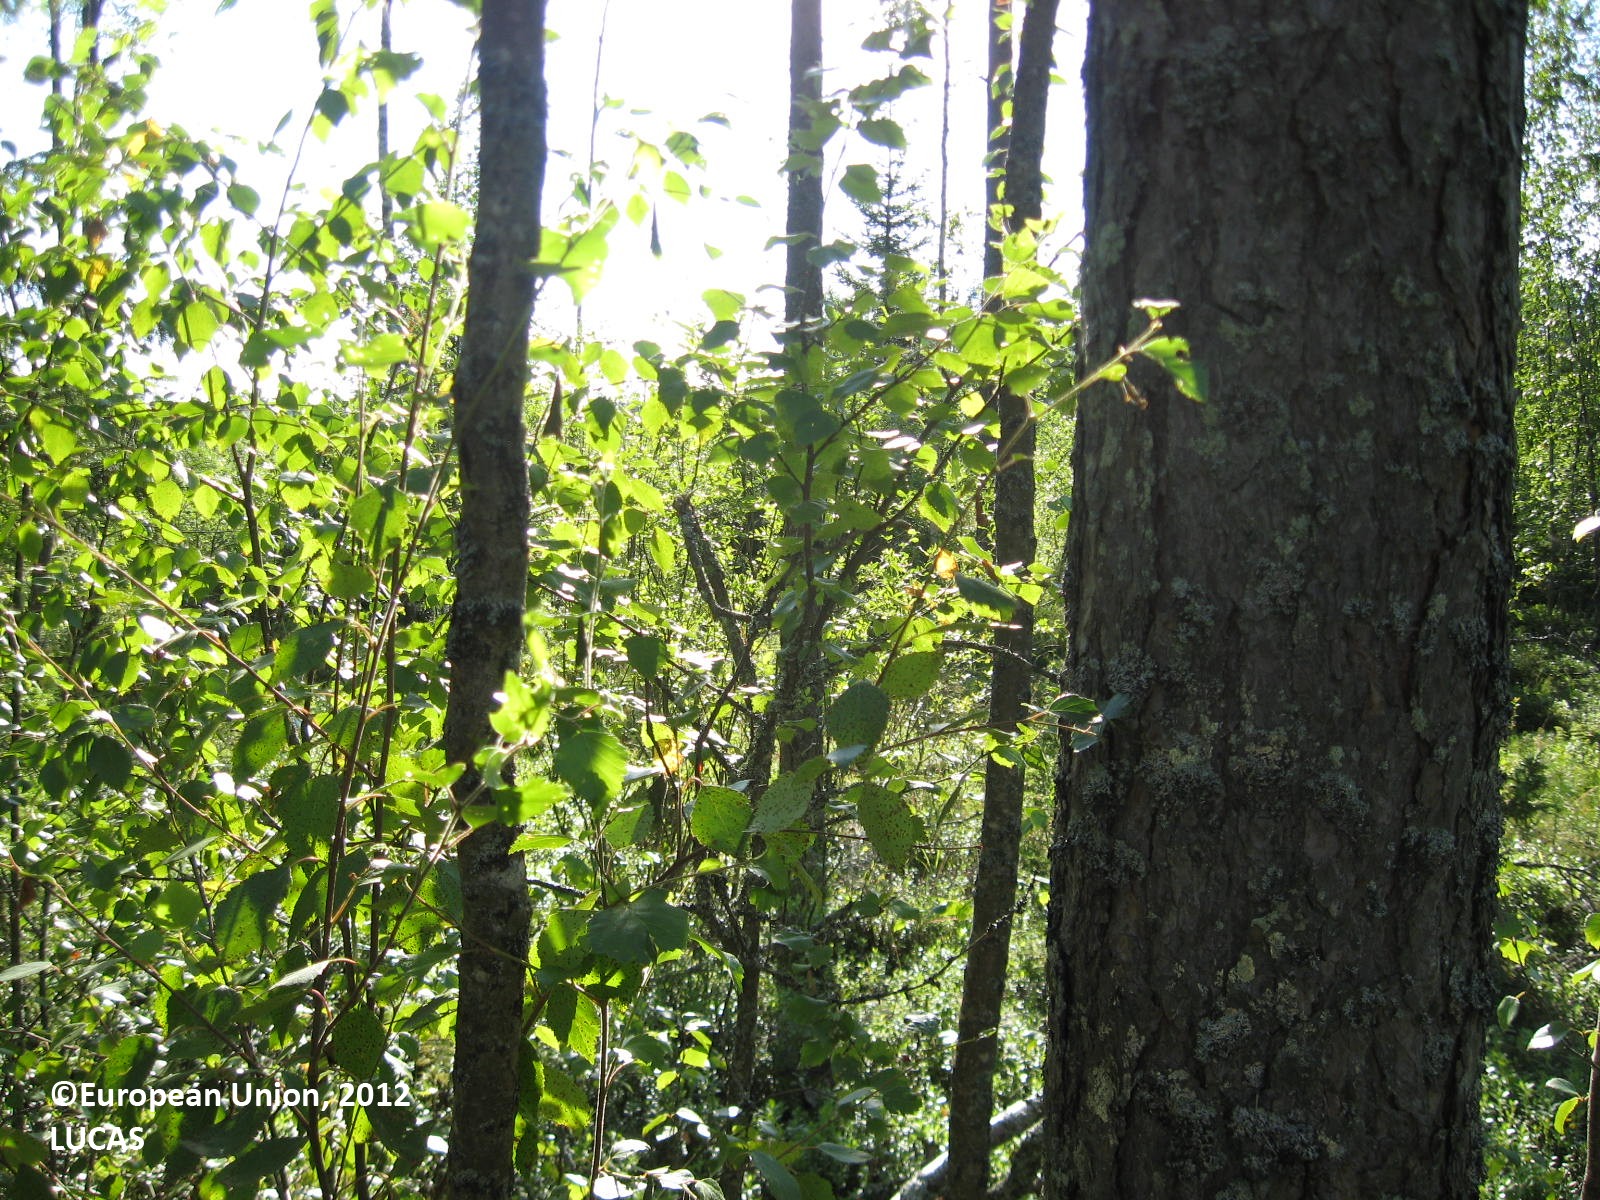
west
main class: Woodland
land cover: Pine dominated mixed woodland
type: boreal forest
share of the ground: > 75 %
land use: Forestry
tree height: > 5 m
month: July
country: FI
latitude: 61.9150
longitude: 22.6098
